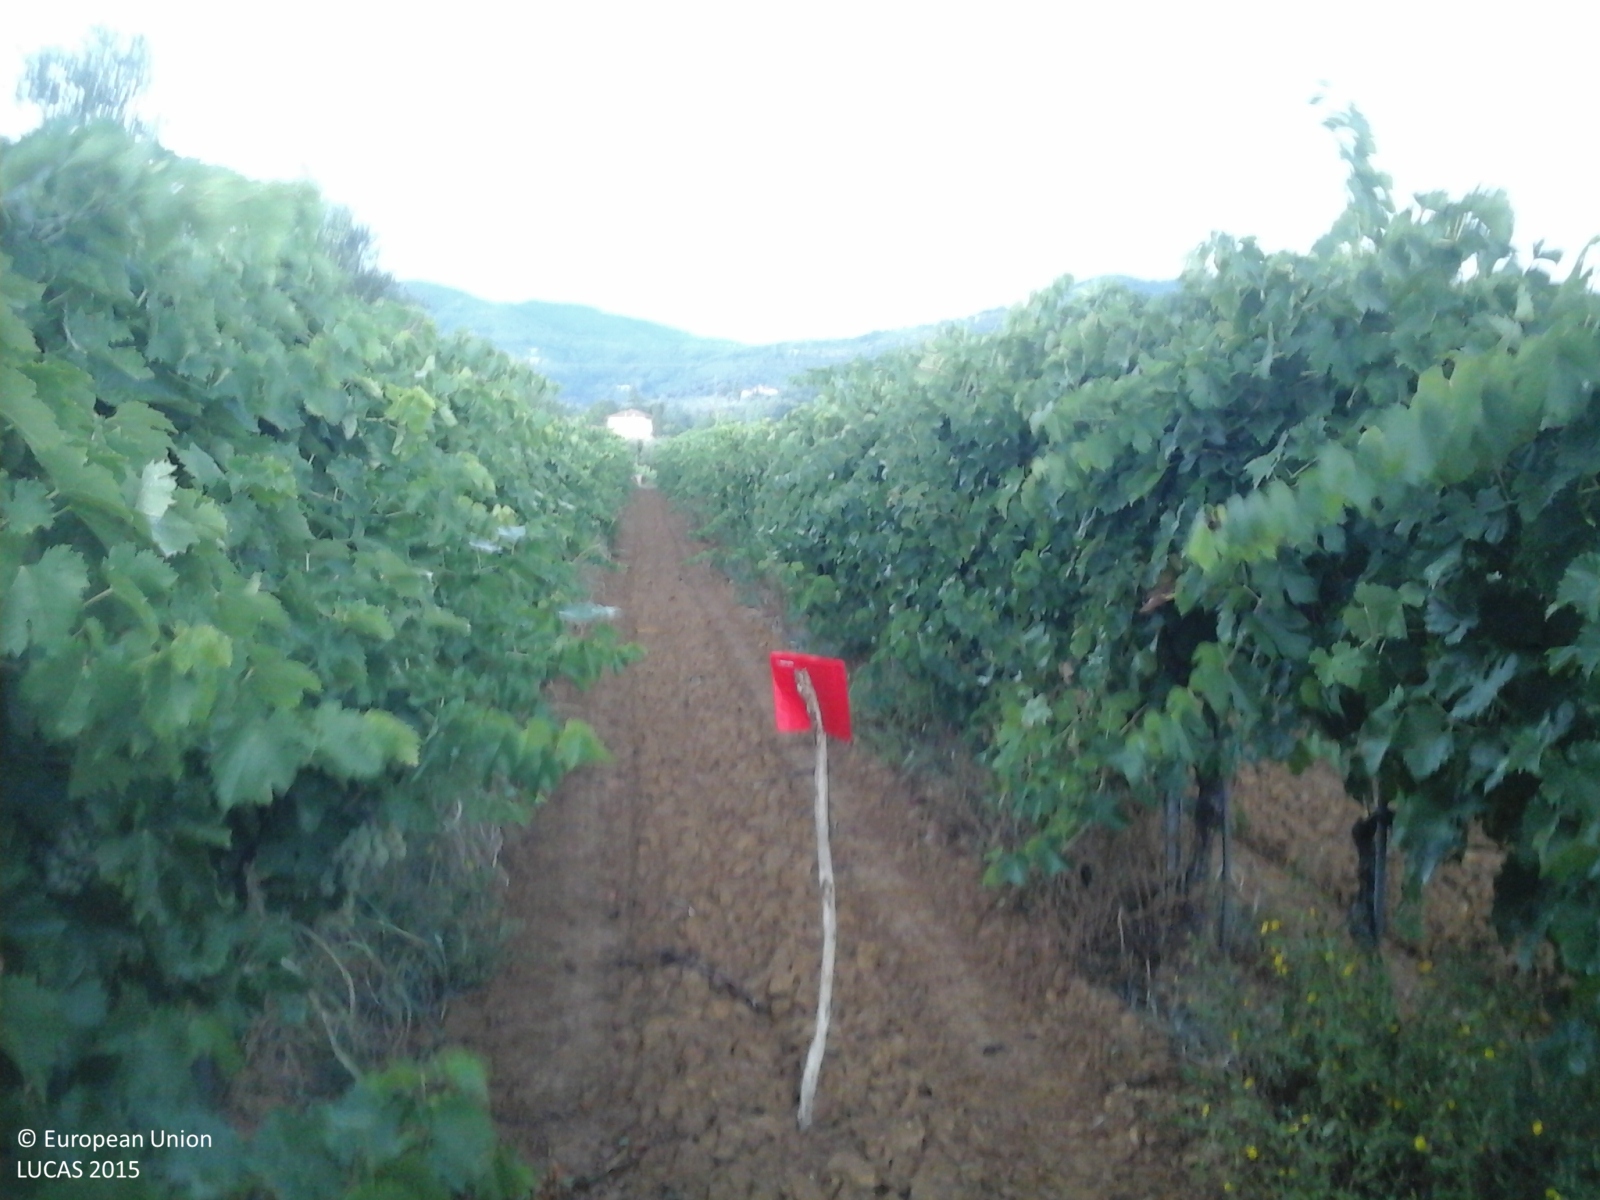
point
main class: Cropland
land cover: Vineyards
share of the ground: > 75 %
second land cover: Other bare soil
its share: > 75 %
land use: Agriculture (excluding fallow land and kitchen gardens)
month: August
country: IT
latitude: 43.8419
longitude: 10.8560
